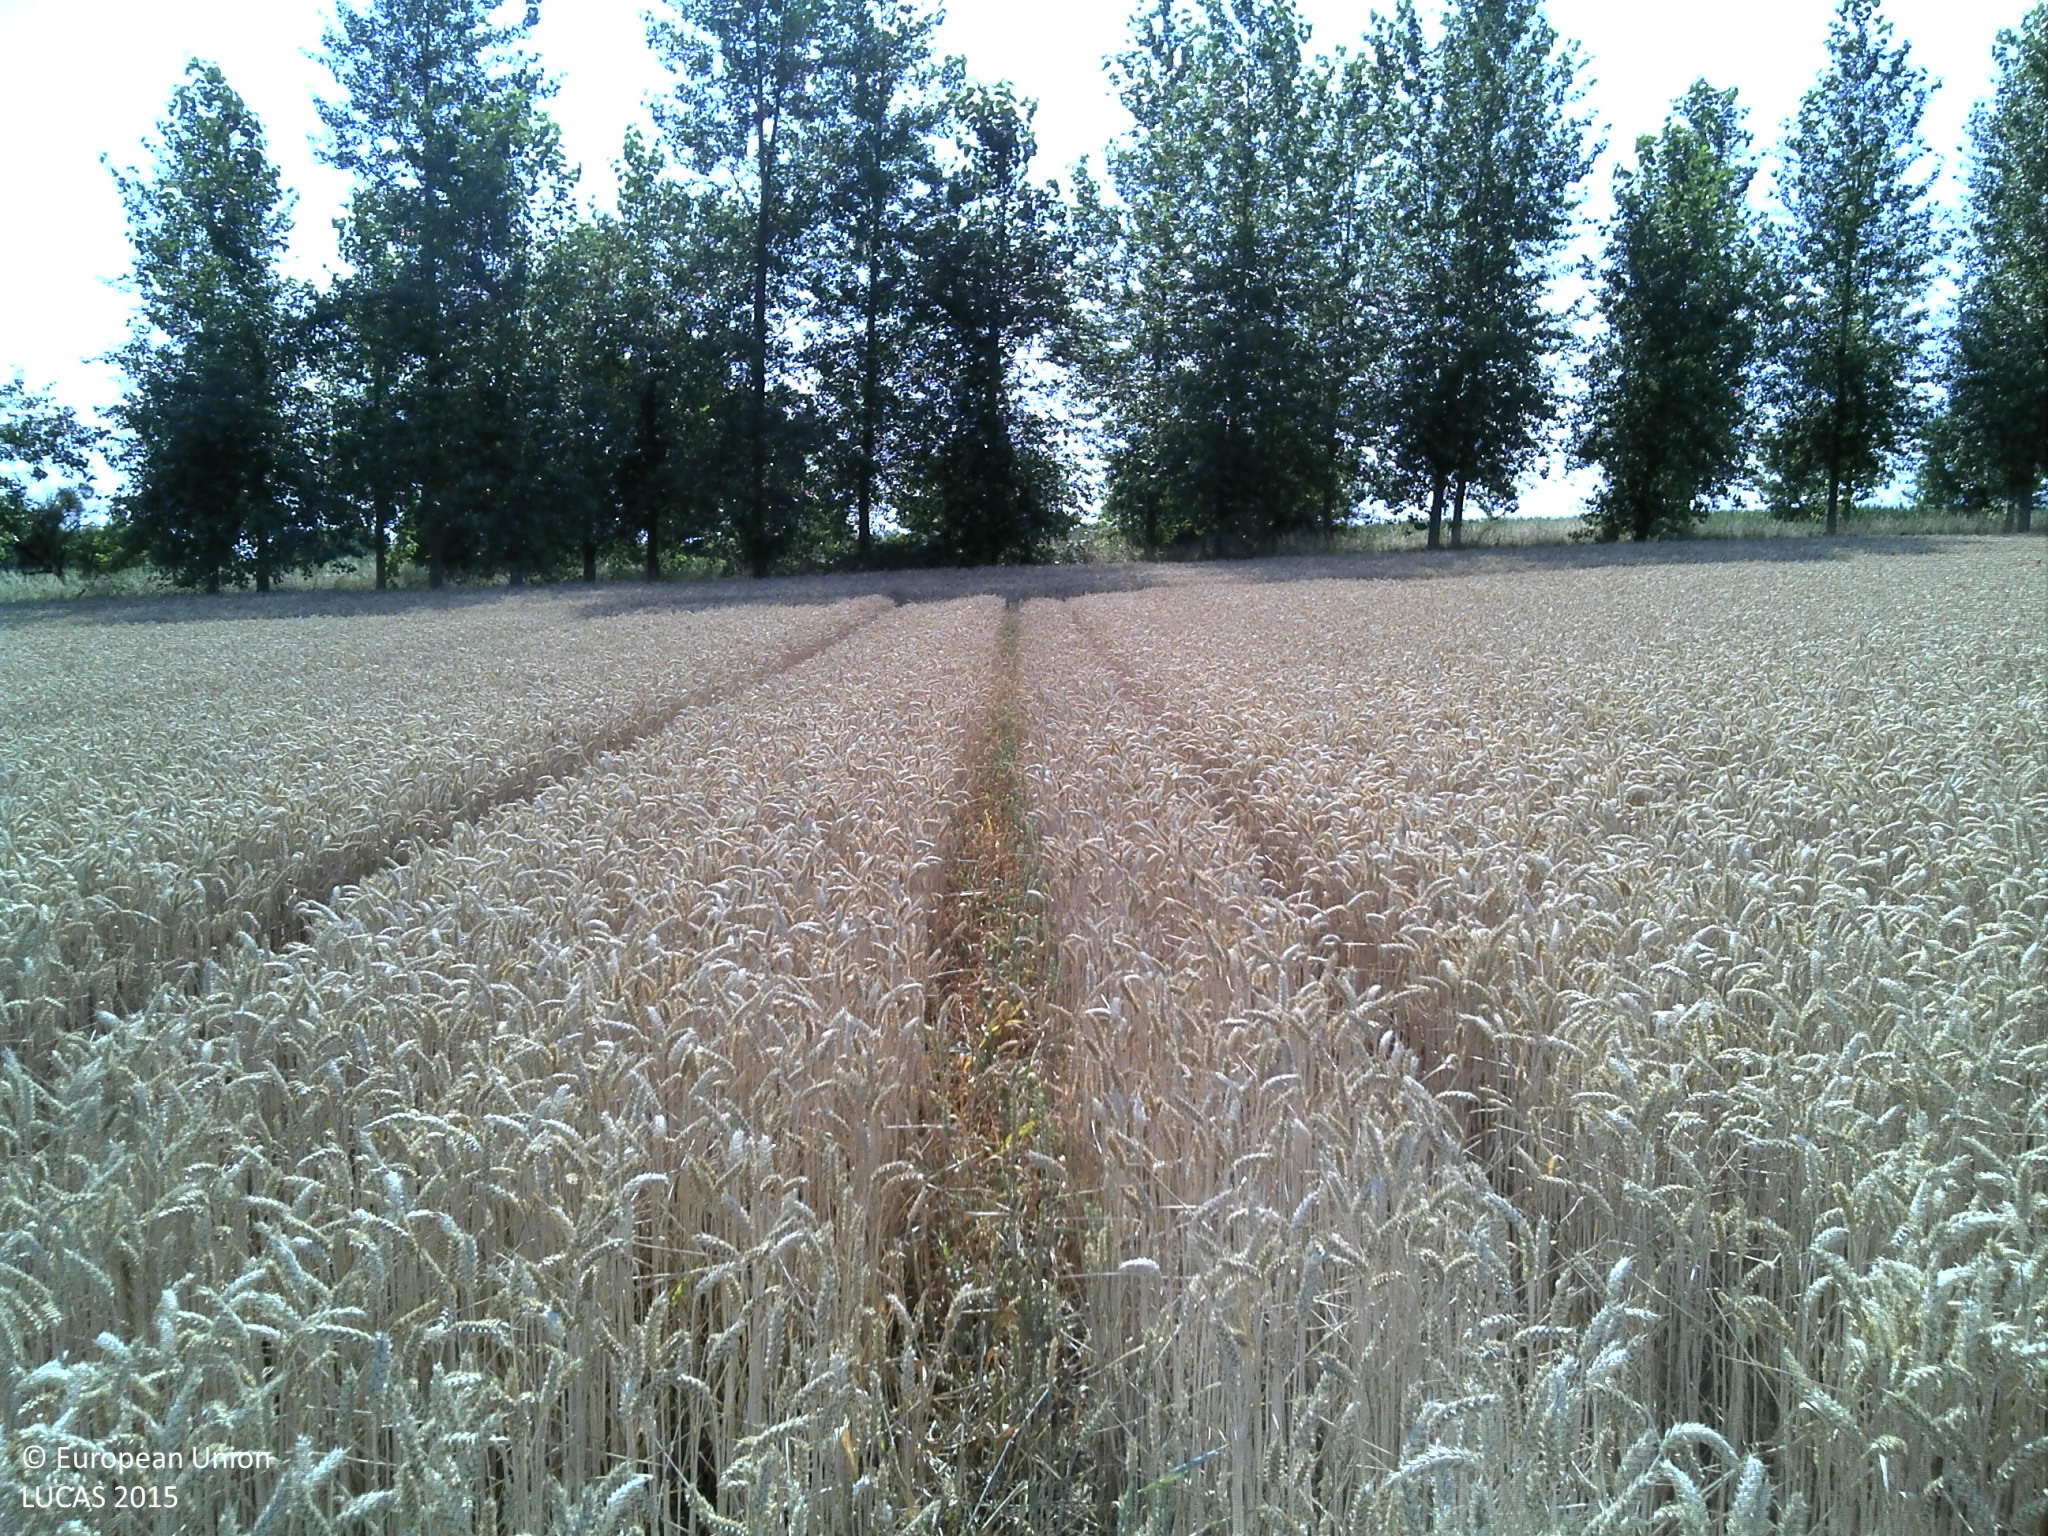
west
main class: Cropland
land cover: Common wheat
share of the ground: > 75 %
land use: Agriculture (excluding fallow land and kitchen gardens)
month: July
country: FR
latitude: 48.6968
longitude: 4.8213
